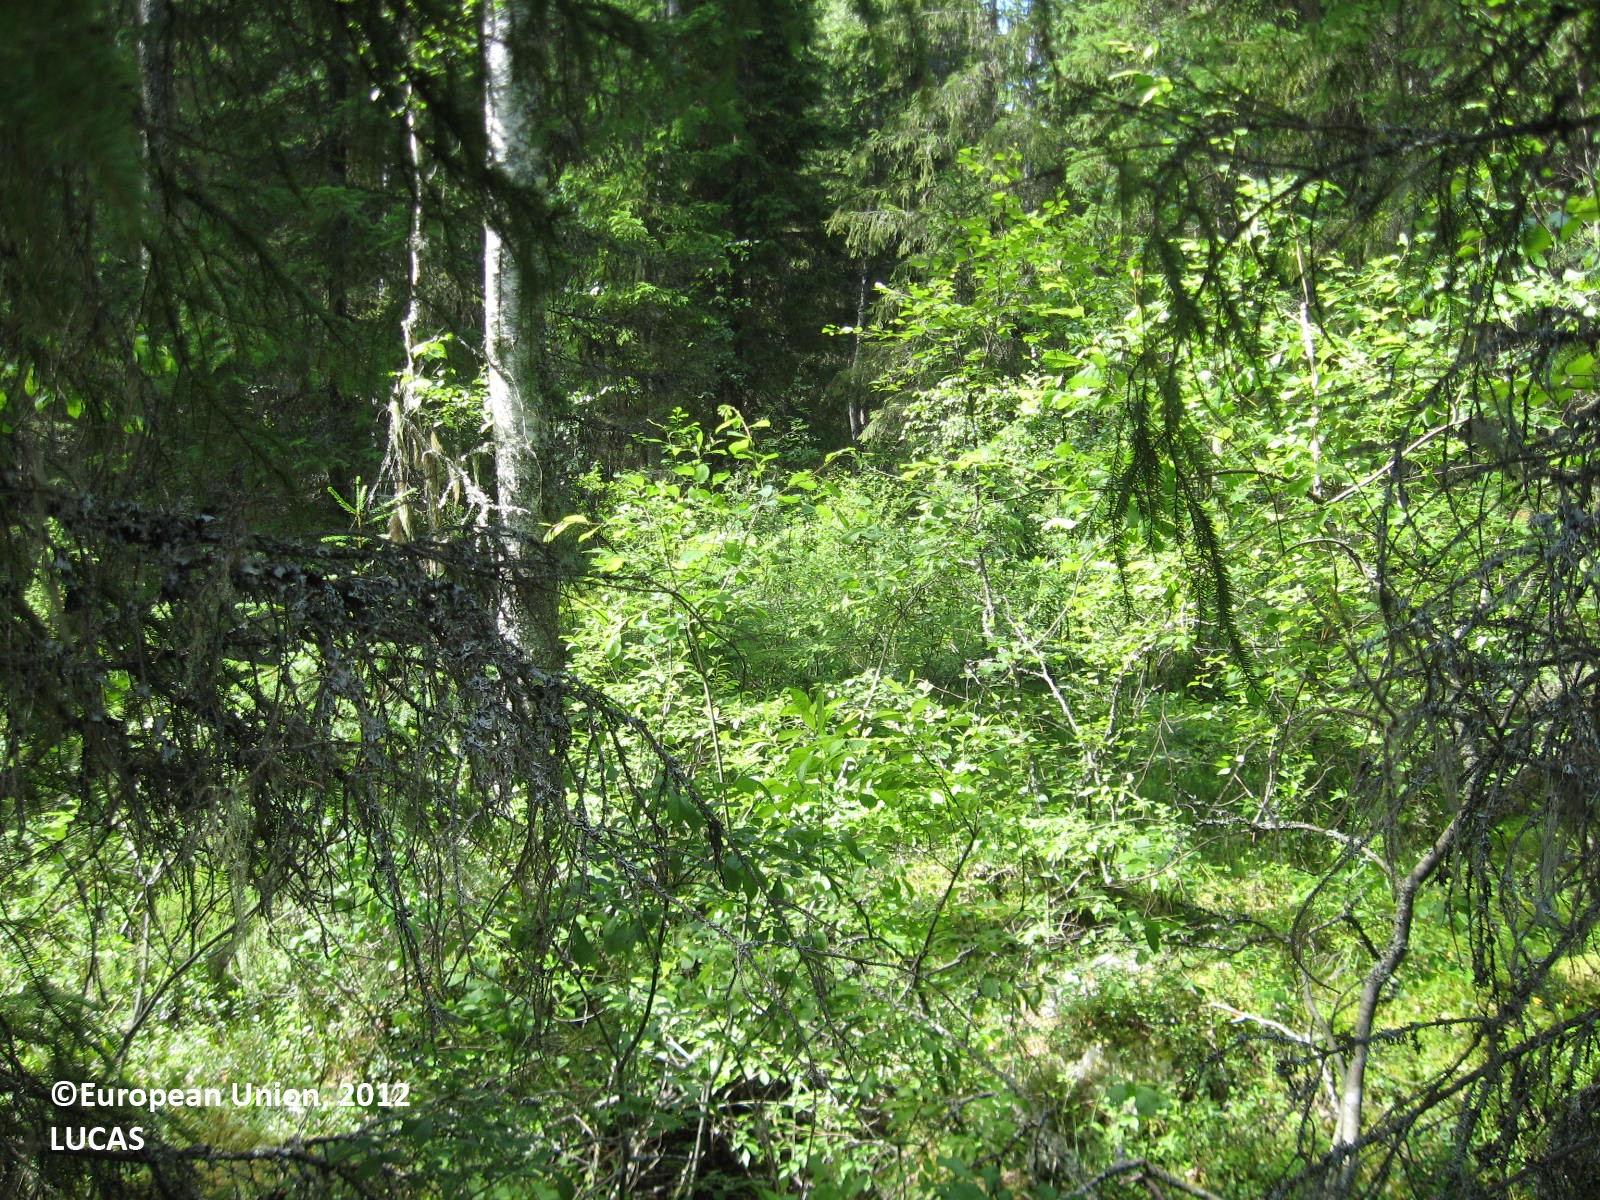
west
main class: Woodland
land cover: Spruce dominated mixed woodland
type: boreal forest
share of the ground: > 75 %
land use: Forestry
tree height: > 5 m
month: July
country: FI
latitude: 62.4593
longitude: 21.5401
